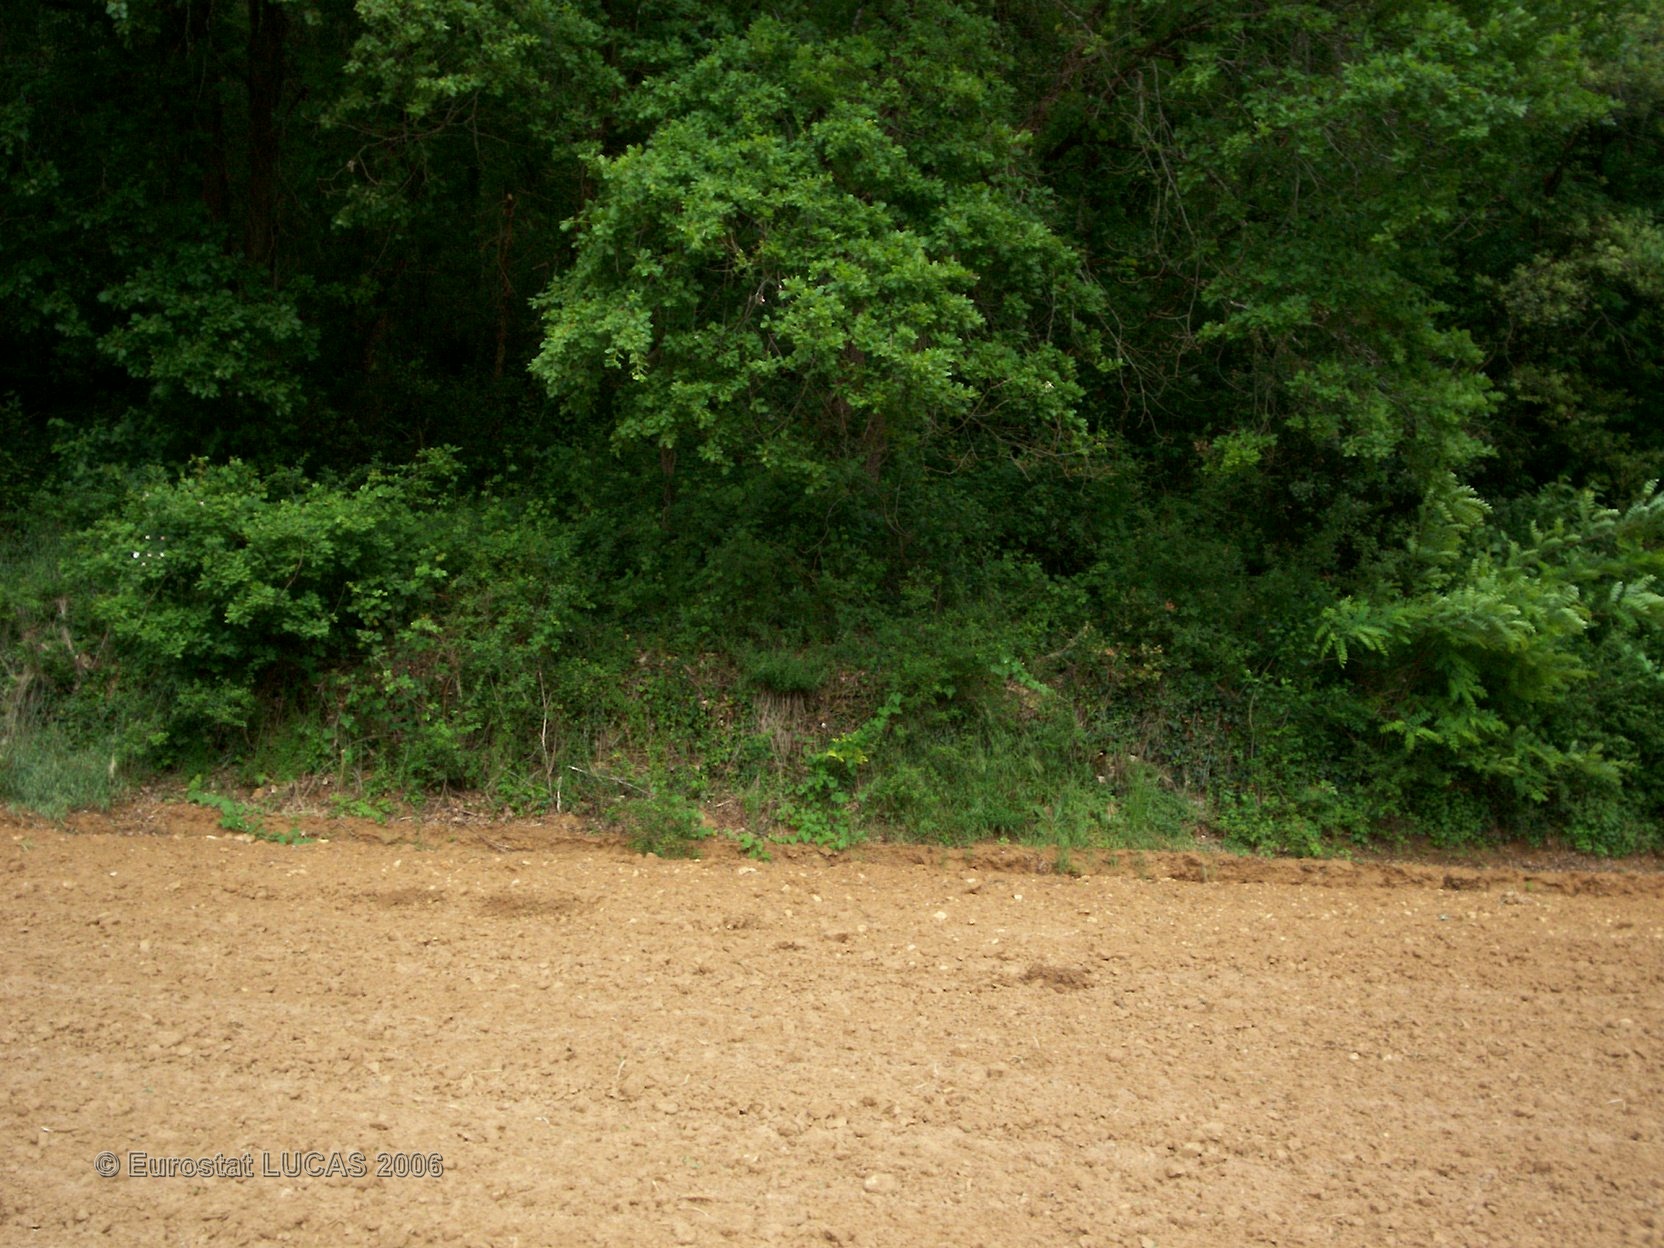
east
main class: Cropland
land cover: Tobacco
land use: Agriculture (excluding fallow land and kitchen gardens)
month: May
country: FR
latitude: 44.8550
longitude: 1.3021
